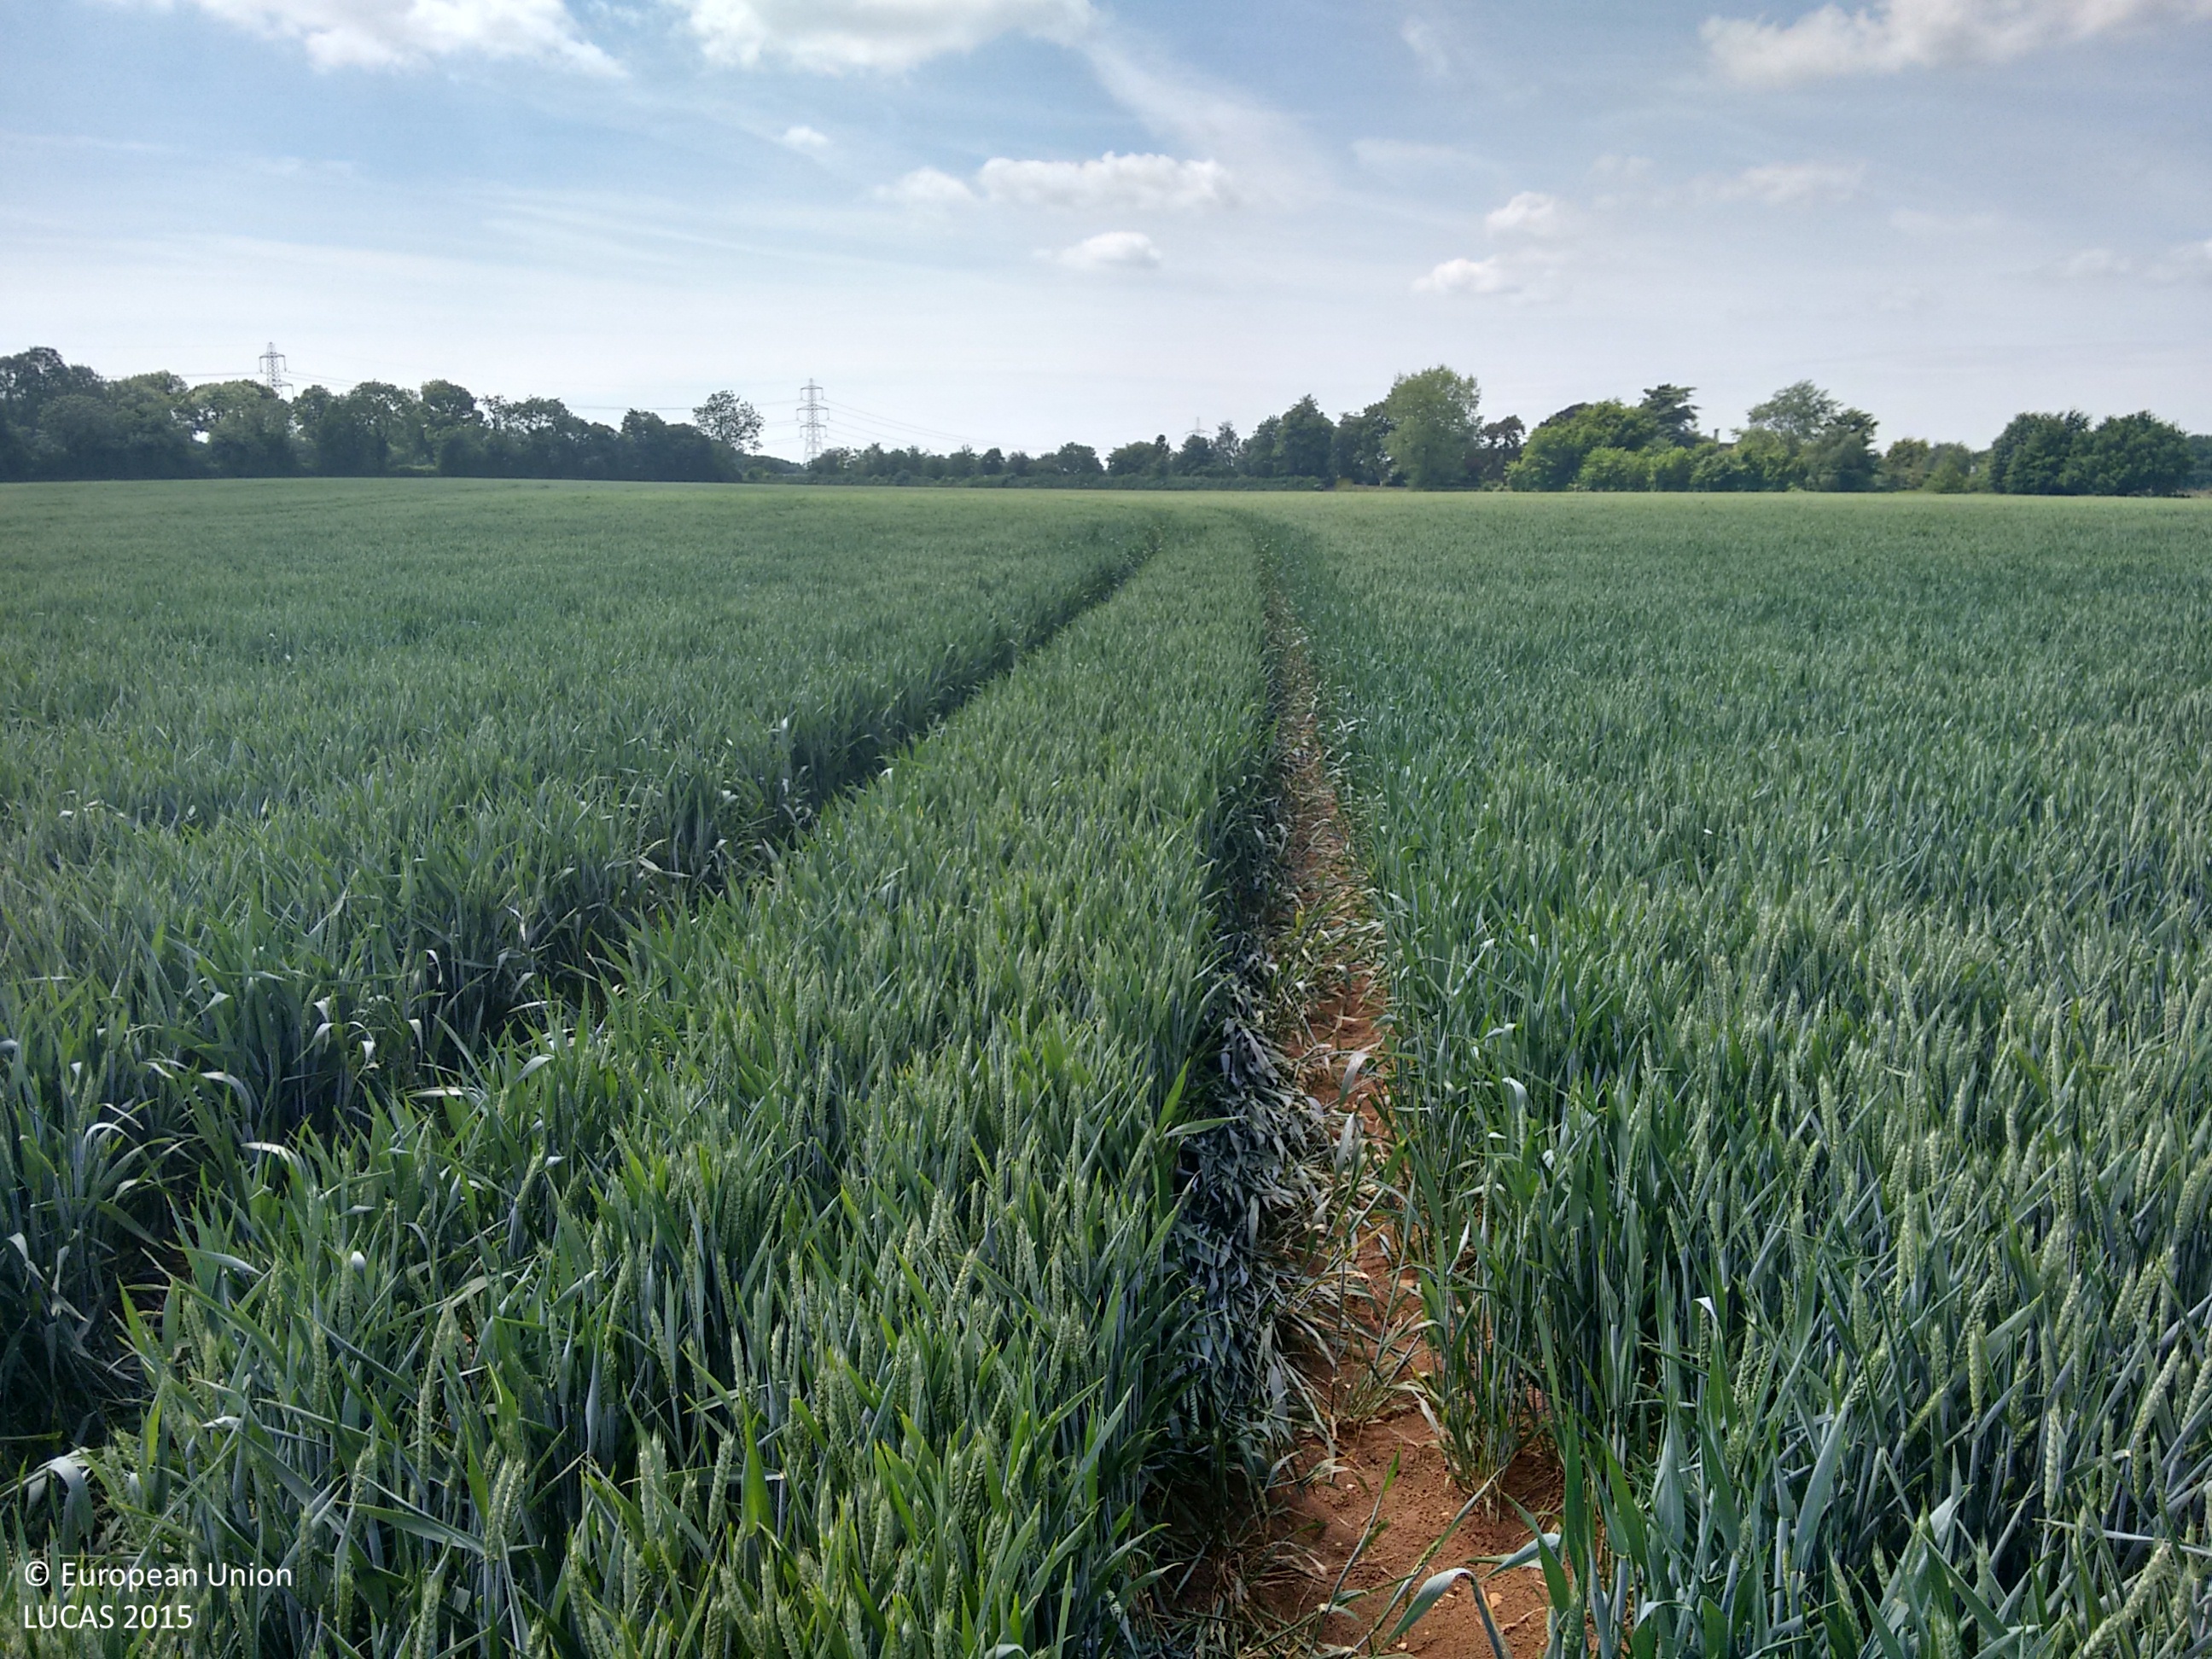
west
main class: Cropland
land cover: Common wheat
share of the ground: > 75 %
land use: Agriculture (excluding fallow land and kitchen gardens)
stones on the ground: < 10 %
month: June
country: GB
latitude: 51.5080
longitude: -2.2077
